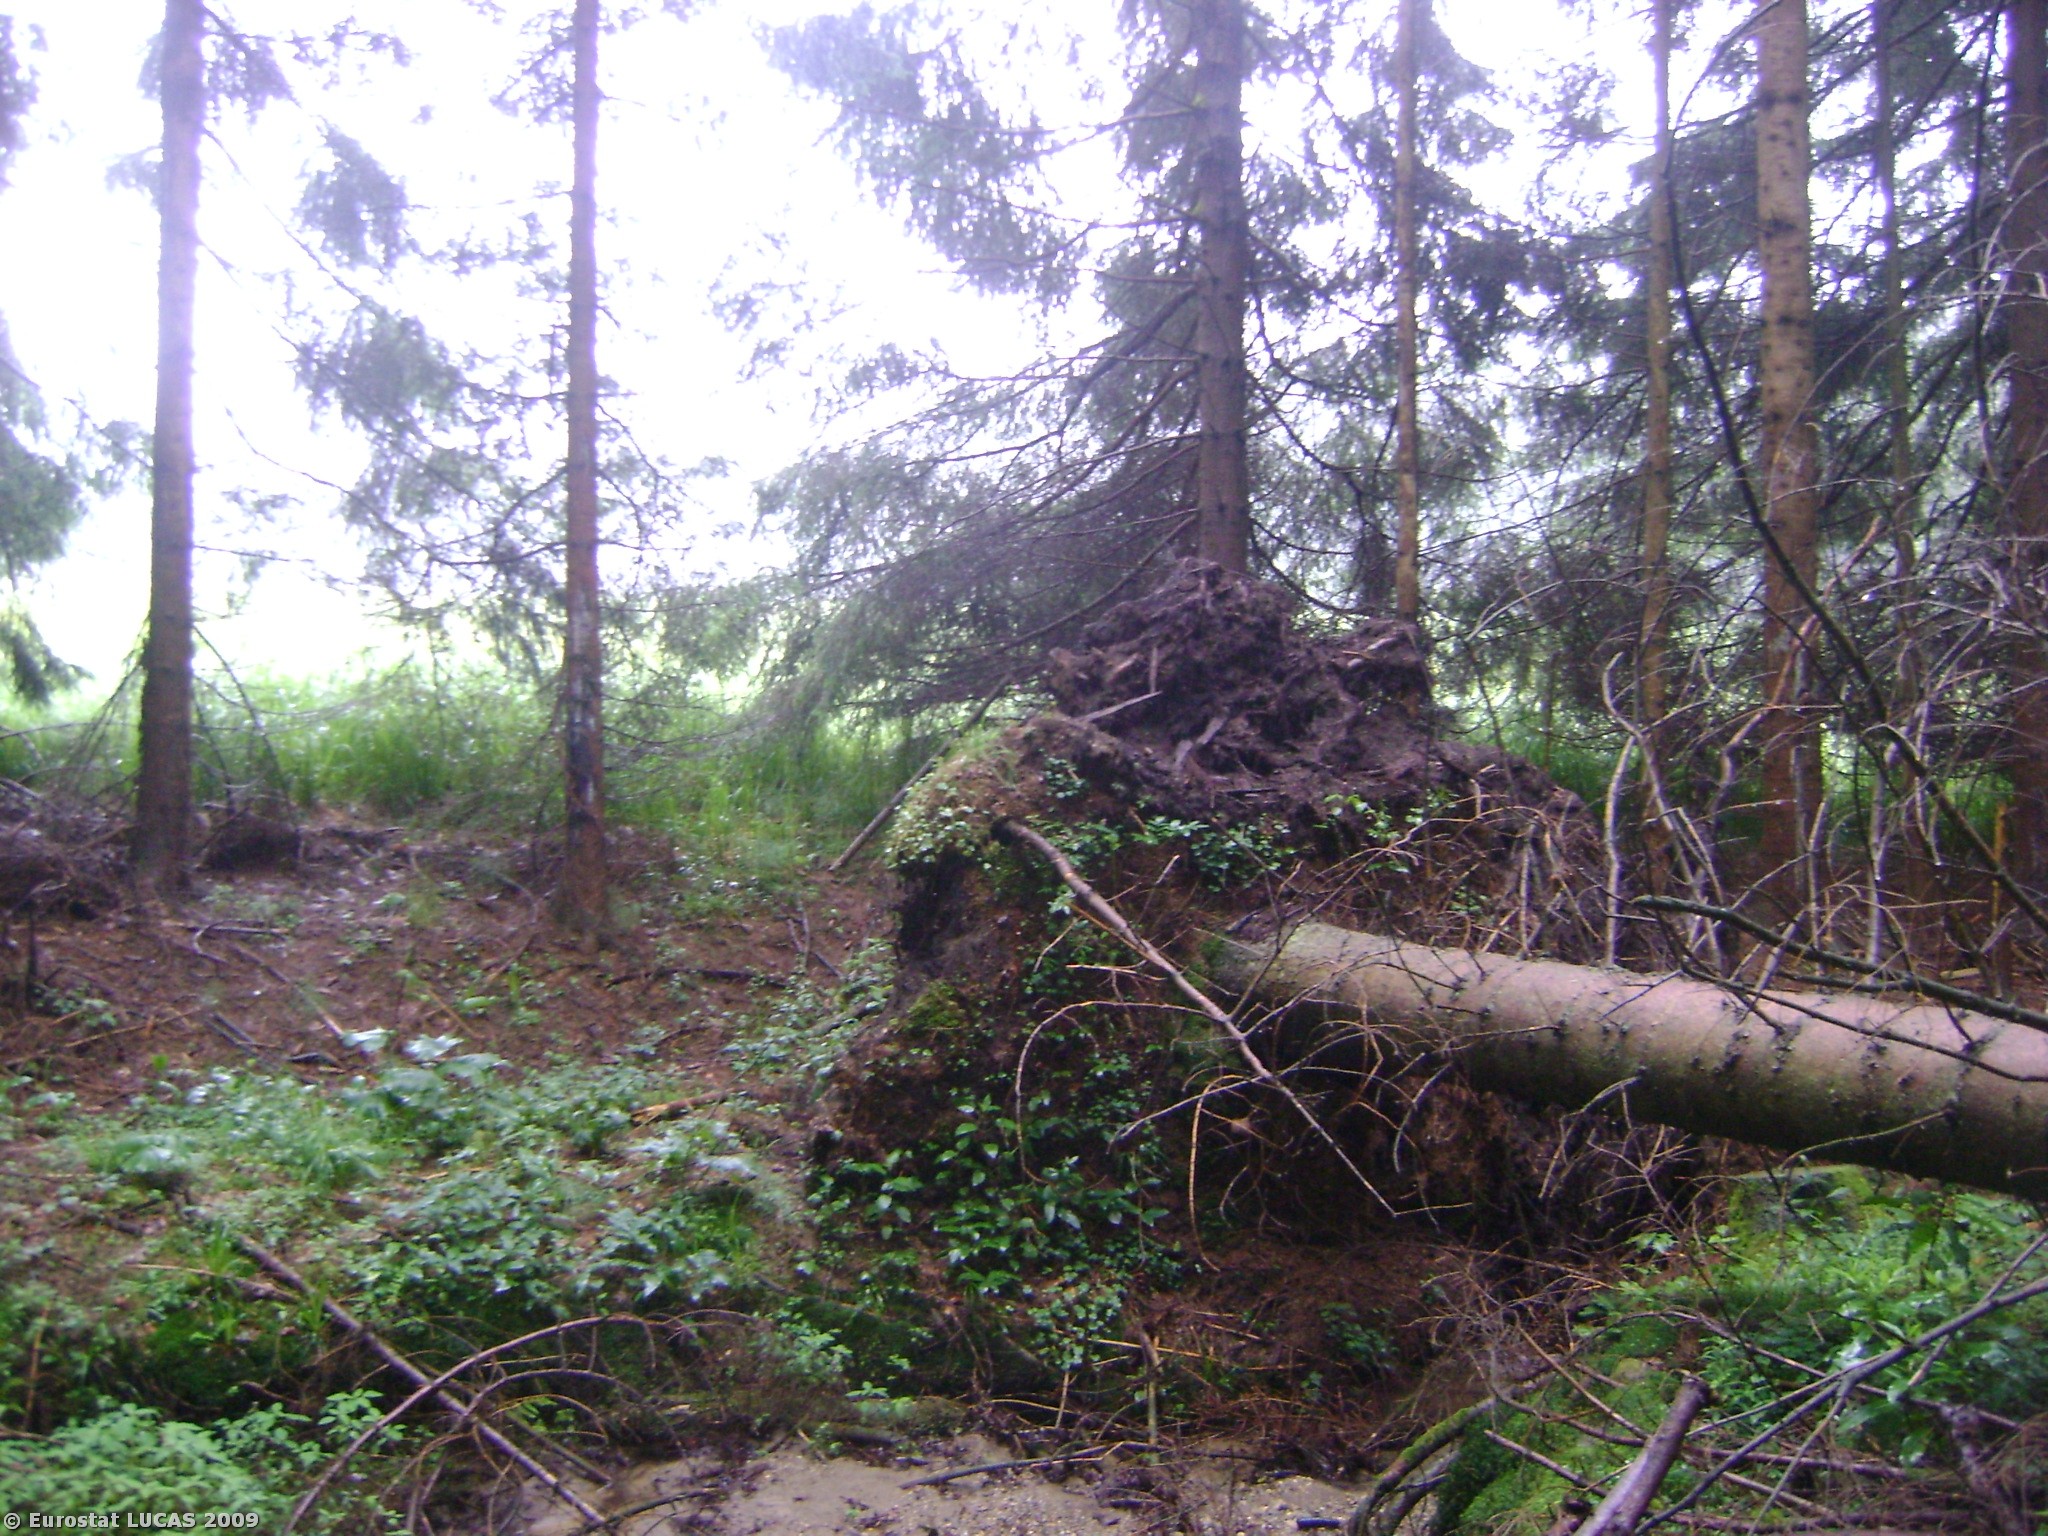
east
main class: Woodland
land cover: Coniferous woodland
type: hemiboreal forest and nemoral coniferous forest and mixed broadleaved-coniferous forest
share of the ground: > 75 %
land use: Forestry
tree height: > 5 m
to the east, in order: Coniferous woodland; Ditches and canals; Coniferous woodland; Inland marshes; Grassland without tree/shrub cover; Coniferous woodland; Inland marshes; Ditches and canals; Grassland without tree/shrub cover; Coniferous woodland; Tracks; Coniferous woodland; Inland running water; Coniferous woodland
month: June
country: AT
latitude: 47.8696
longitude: 13.2474
